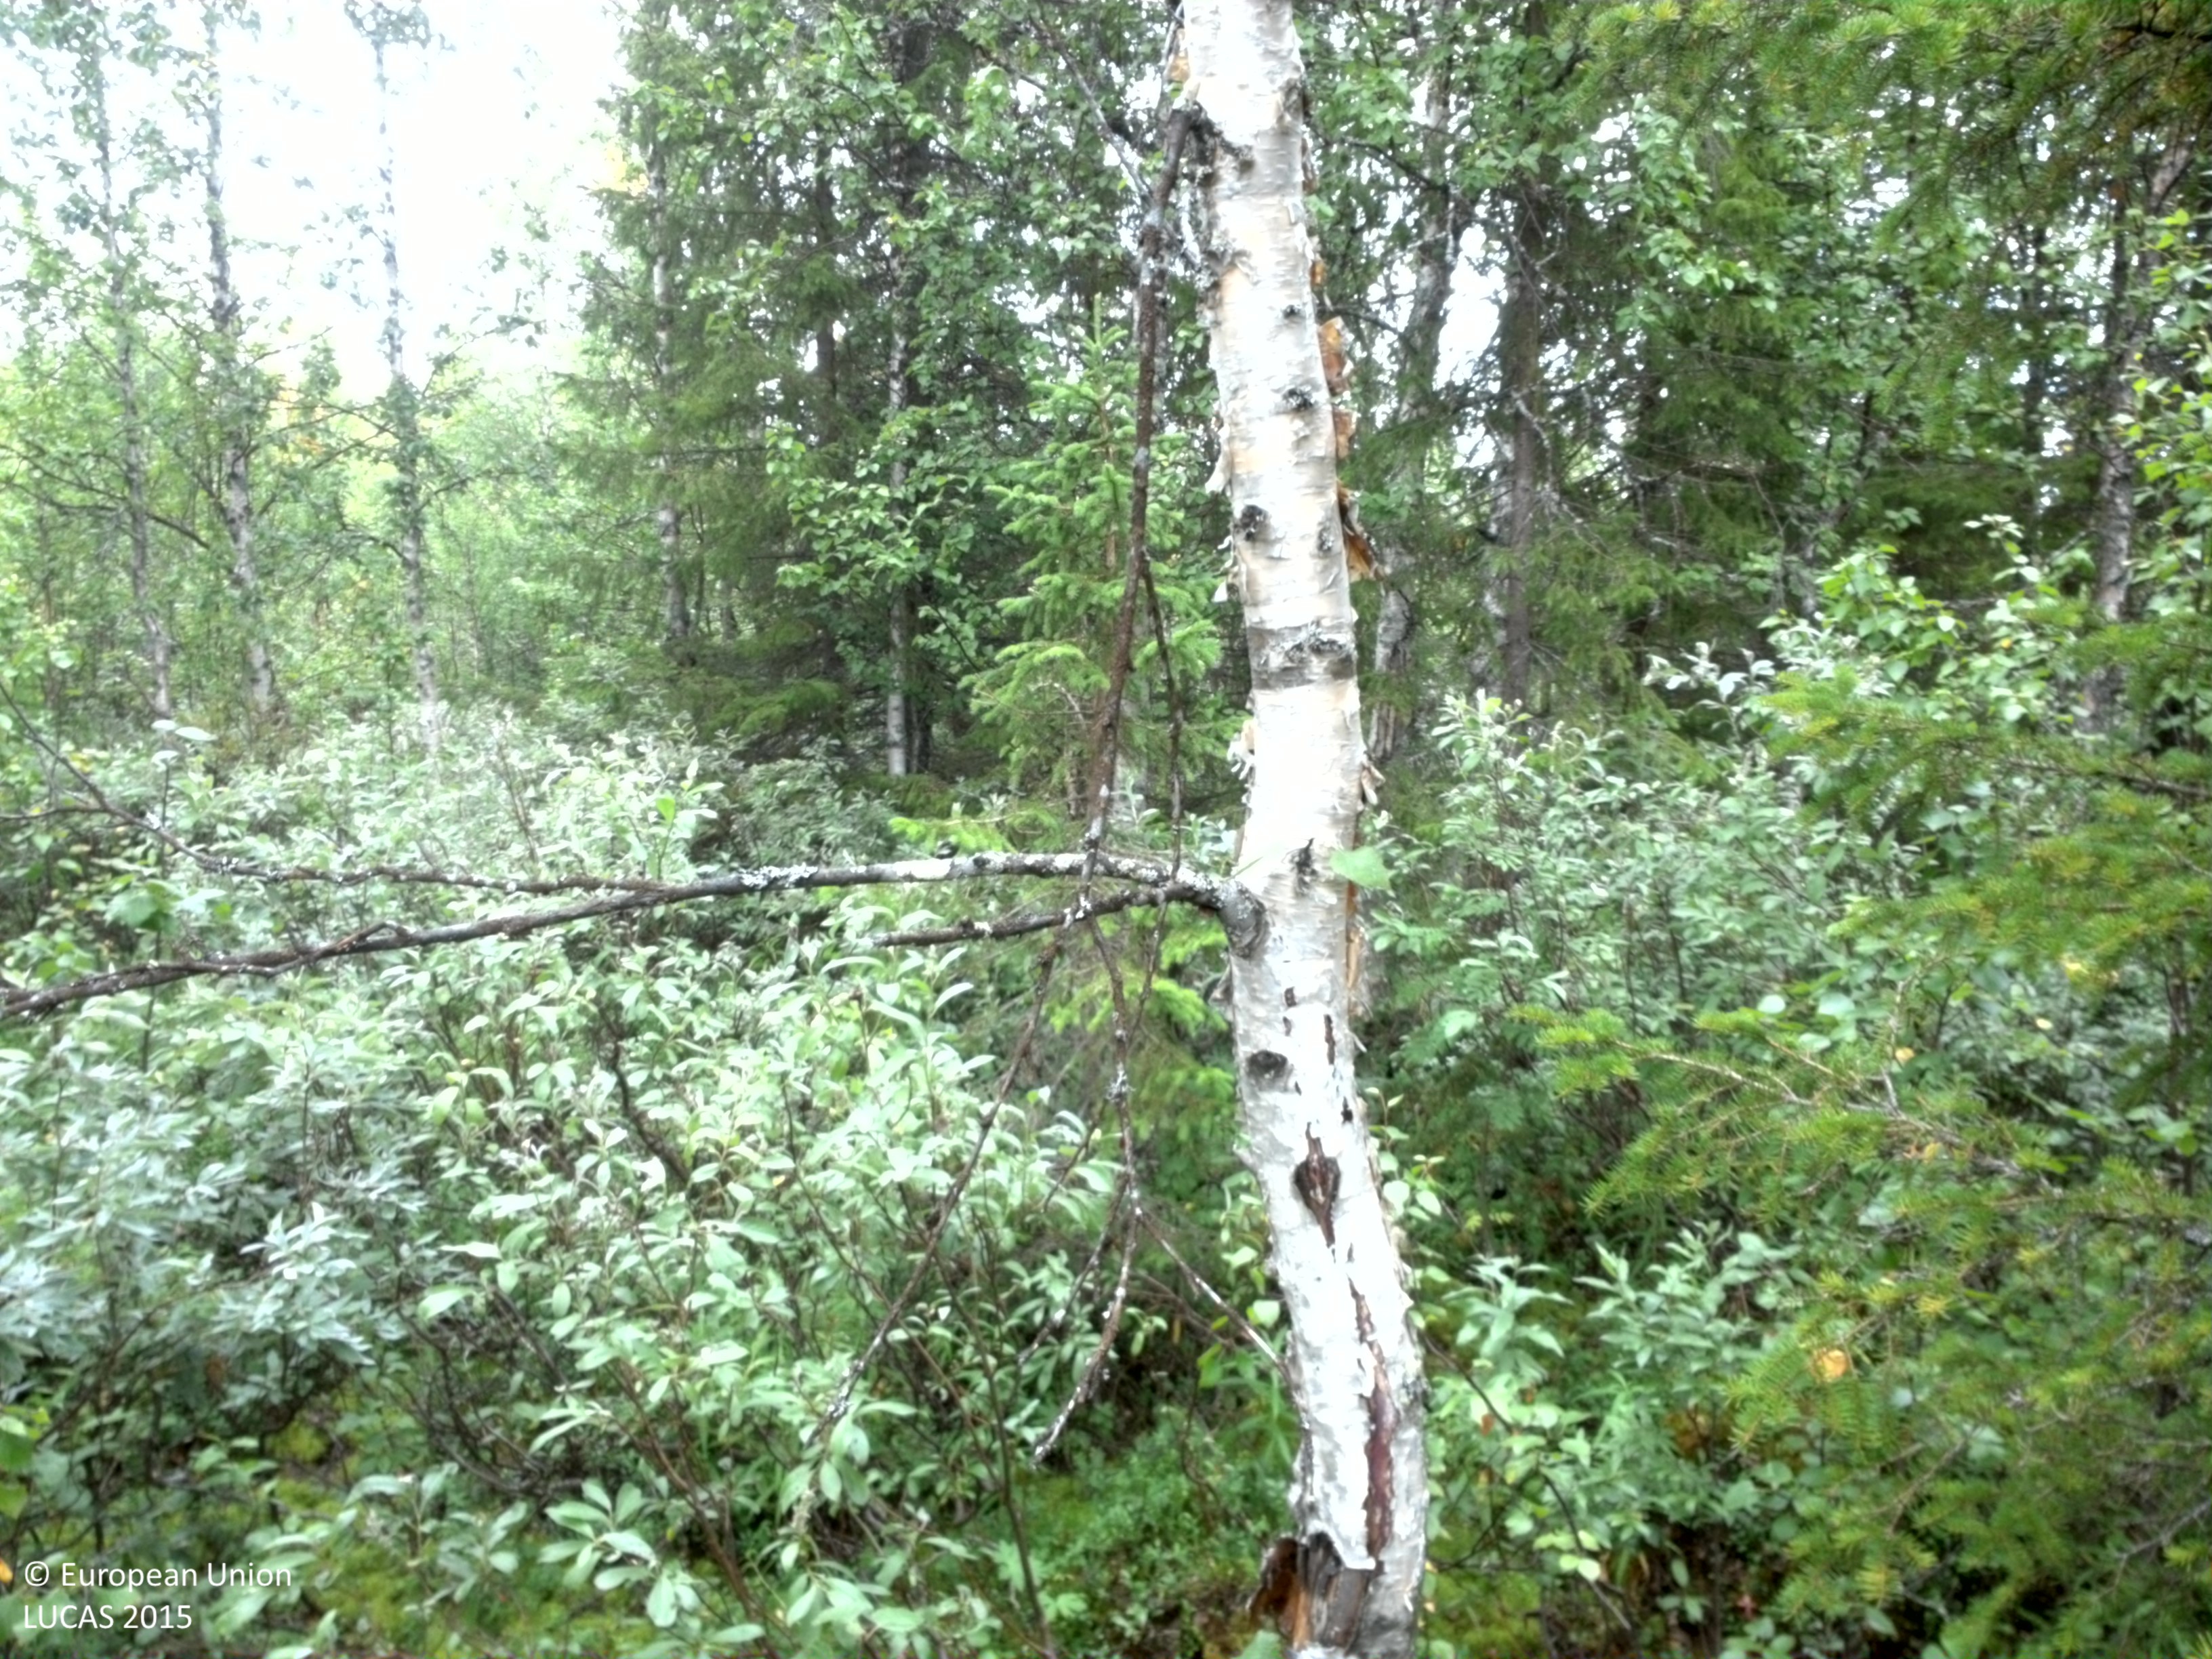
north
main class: Woodland
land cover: Spruce dominated mixed woodland
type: boreal forest
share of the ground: 50 - 75 %
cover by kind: shrubs 45 %, broadleaved forest trees 30 %, coniferous forest trees 20 %, lichens and mosses 5 %
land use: Forestry
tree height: > 5 m
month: August
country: SE
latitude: 64.9219
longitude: 16.8368
